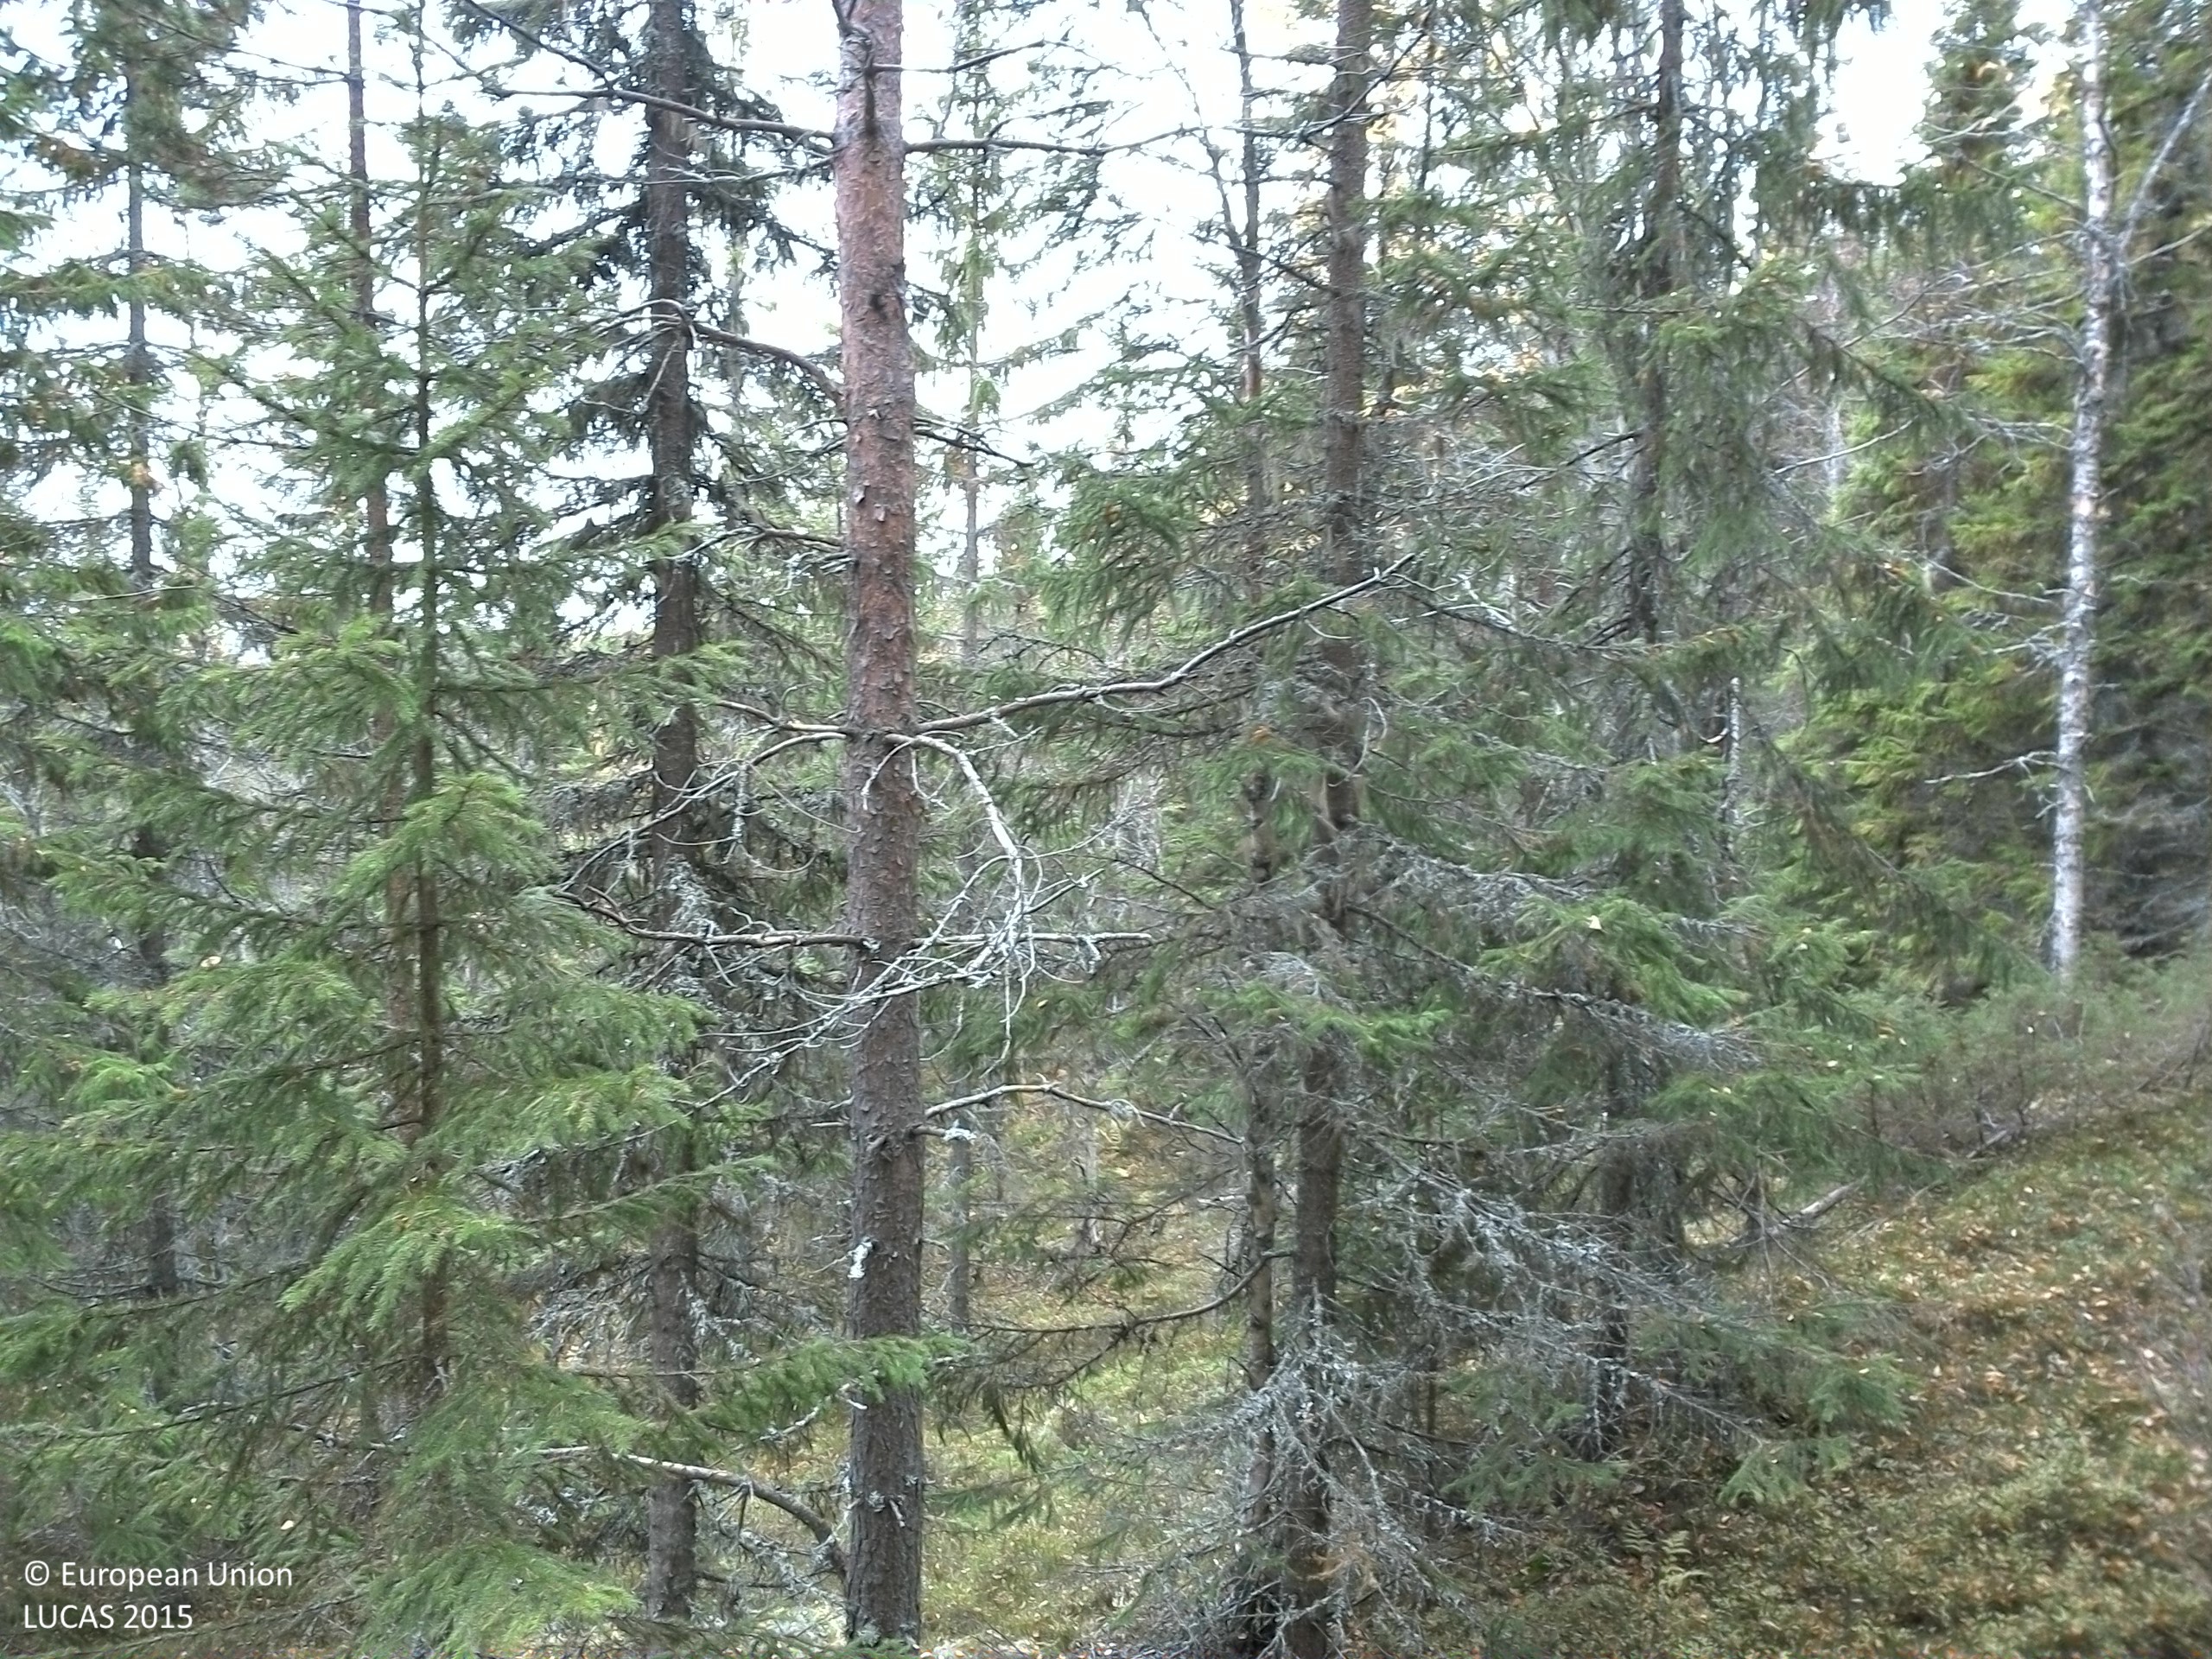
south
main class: Woodland
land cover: Spruce dominated mixed woodland
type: boreal forest
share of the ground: 50 - 75 %
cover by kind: coniferous forest trees 50 %, shrubs 30 %, broadleaved forest trees 20 %
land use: Forestry
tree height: > 5 m
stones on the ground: 10 - 25 %
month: October
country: SE
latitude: 61.4662
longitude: 14.3580
